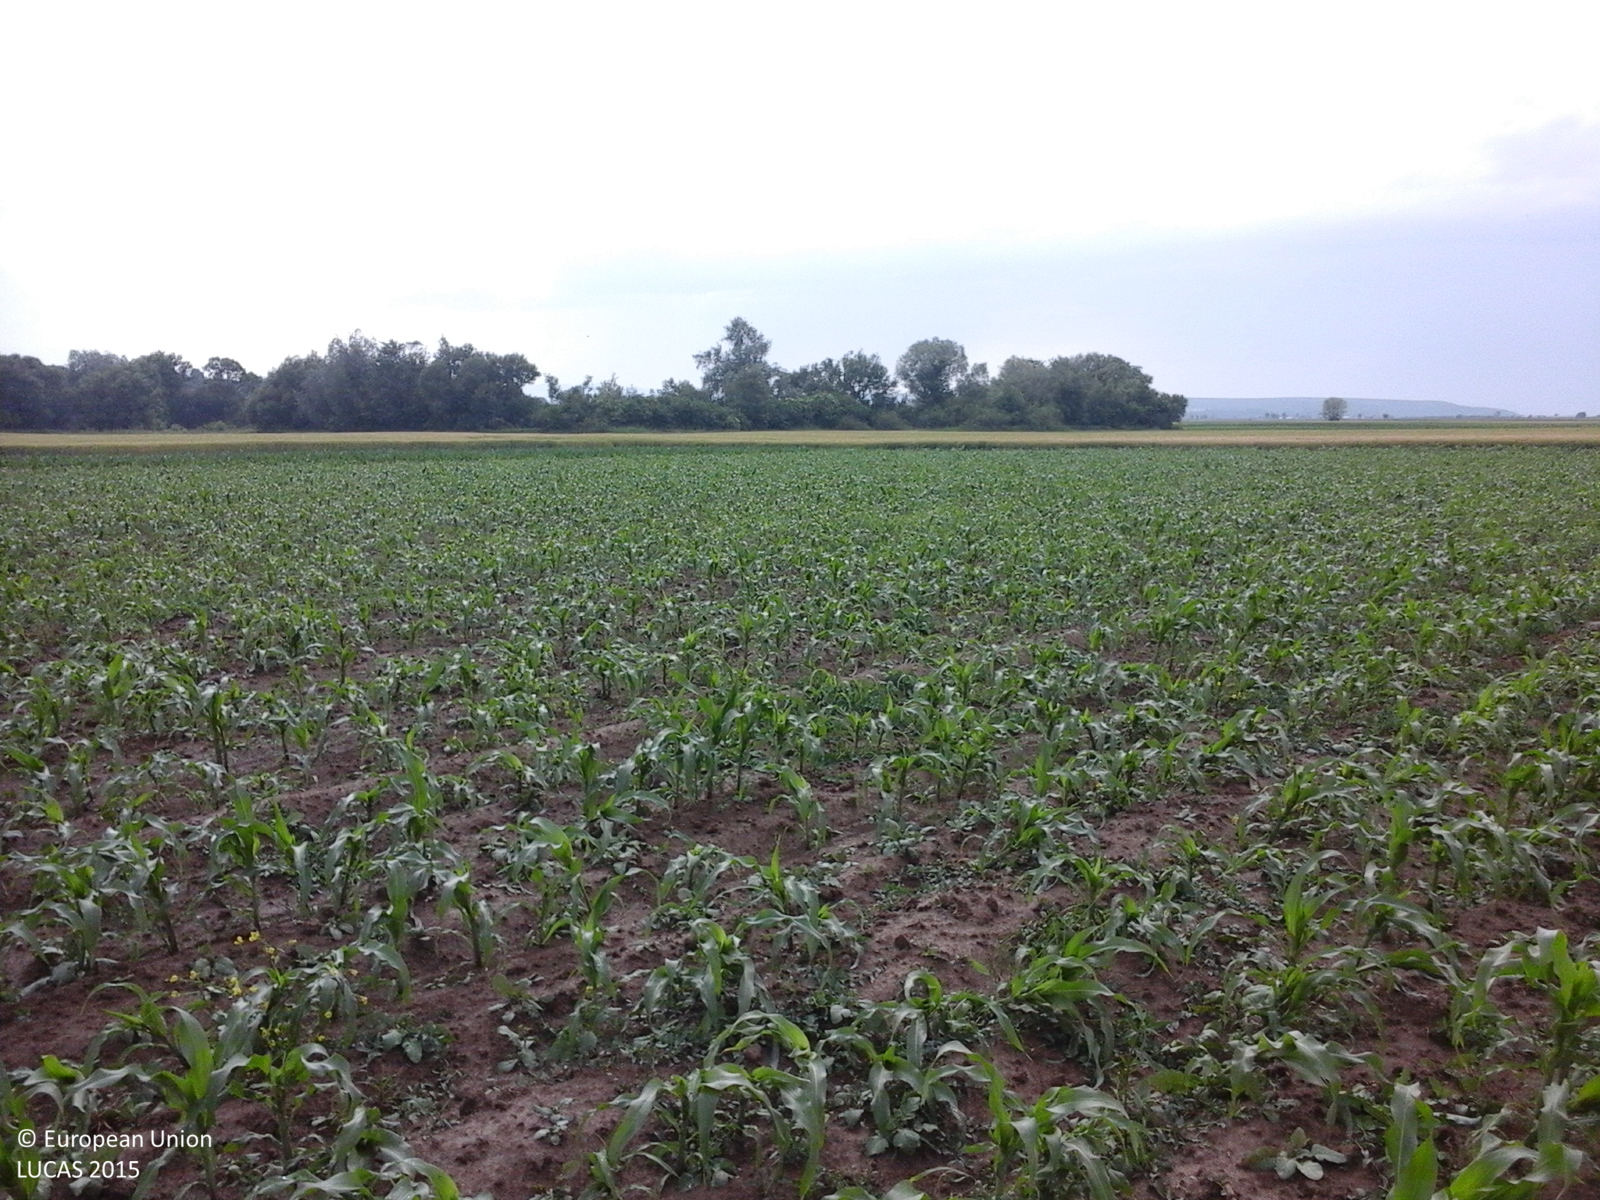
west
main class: Cropland
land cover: Maize
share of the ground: 50 - 75 %
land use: Agriculture (excluding fallow land and kitchen gardens)
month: June
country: RO
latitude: 47.3621
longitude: 26.3297
